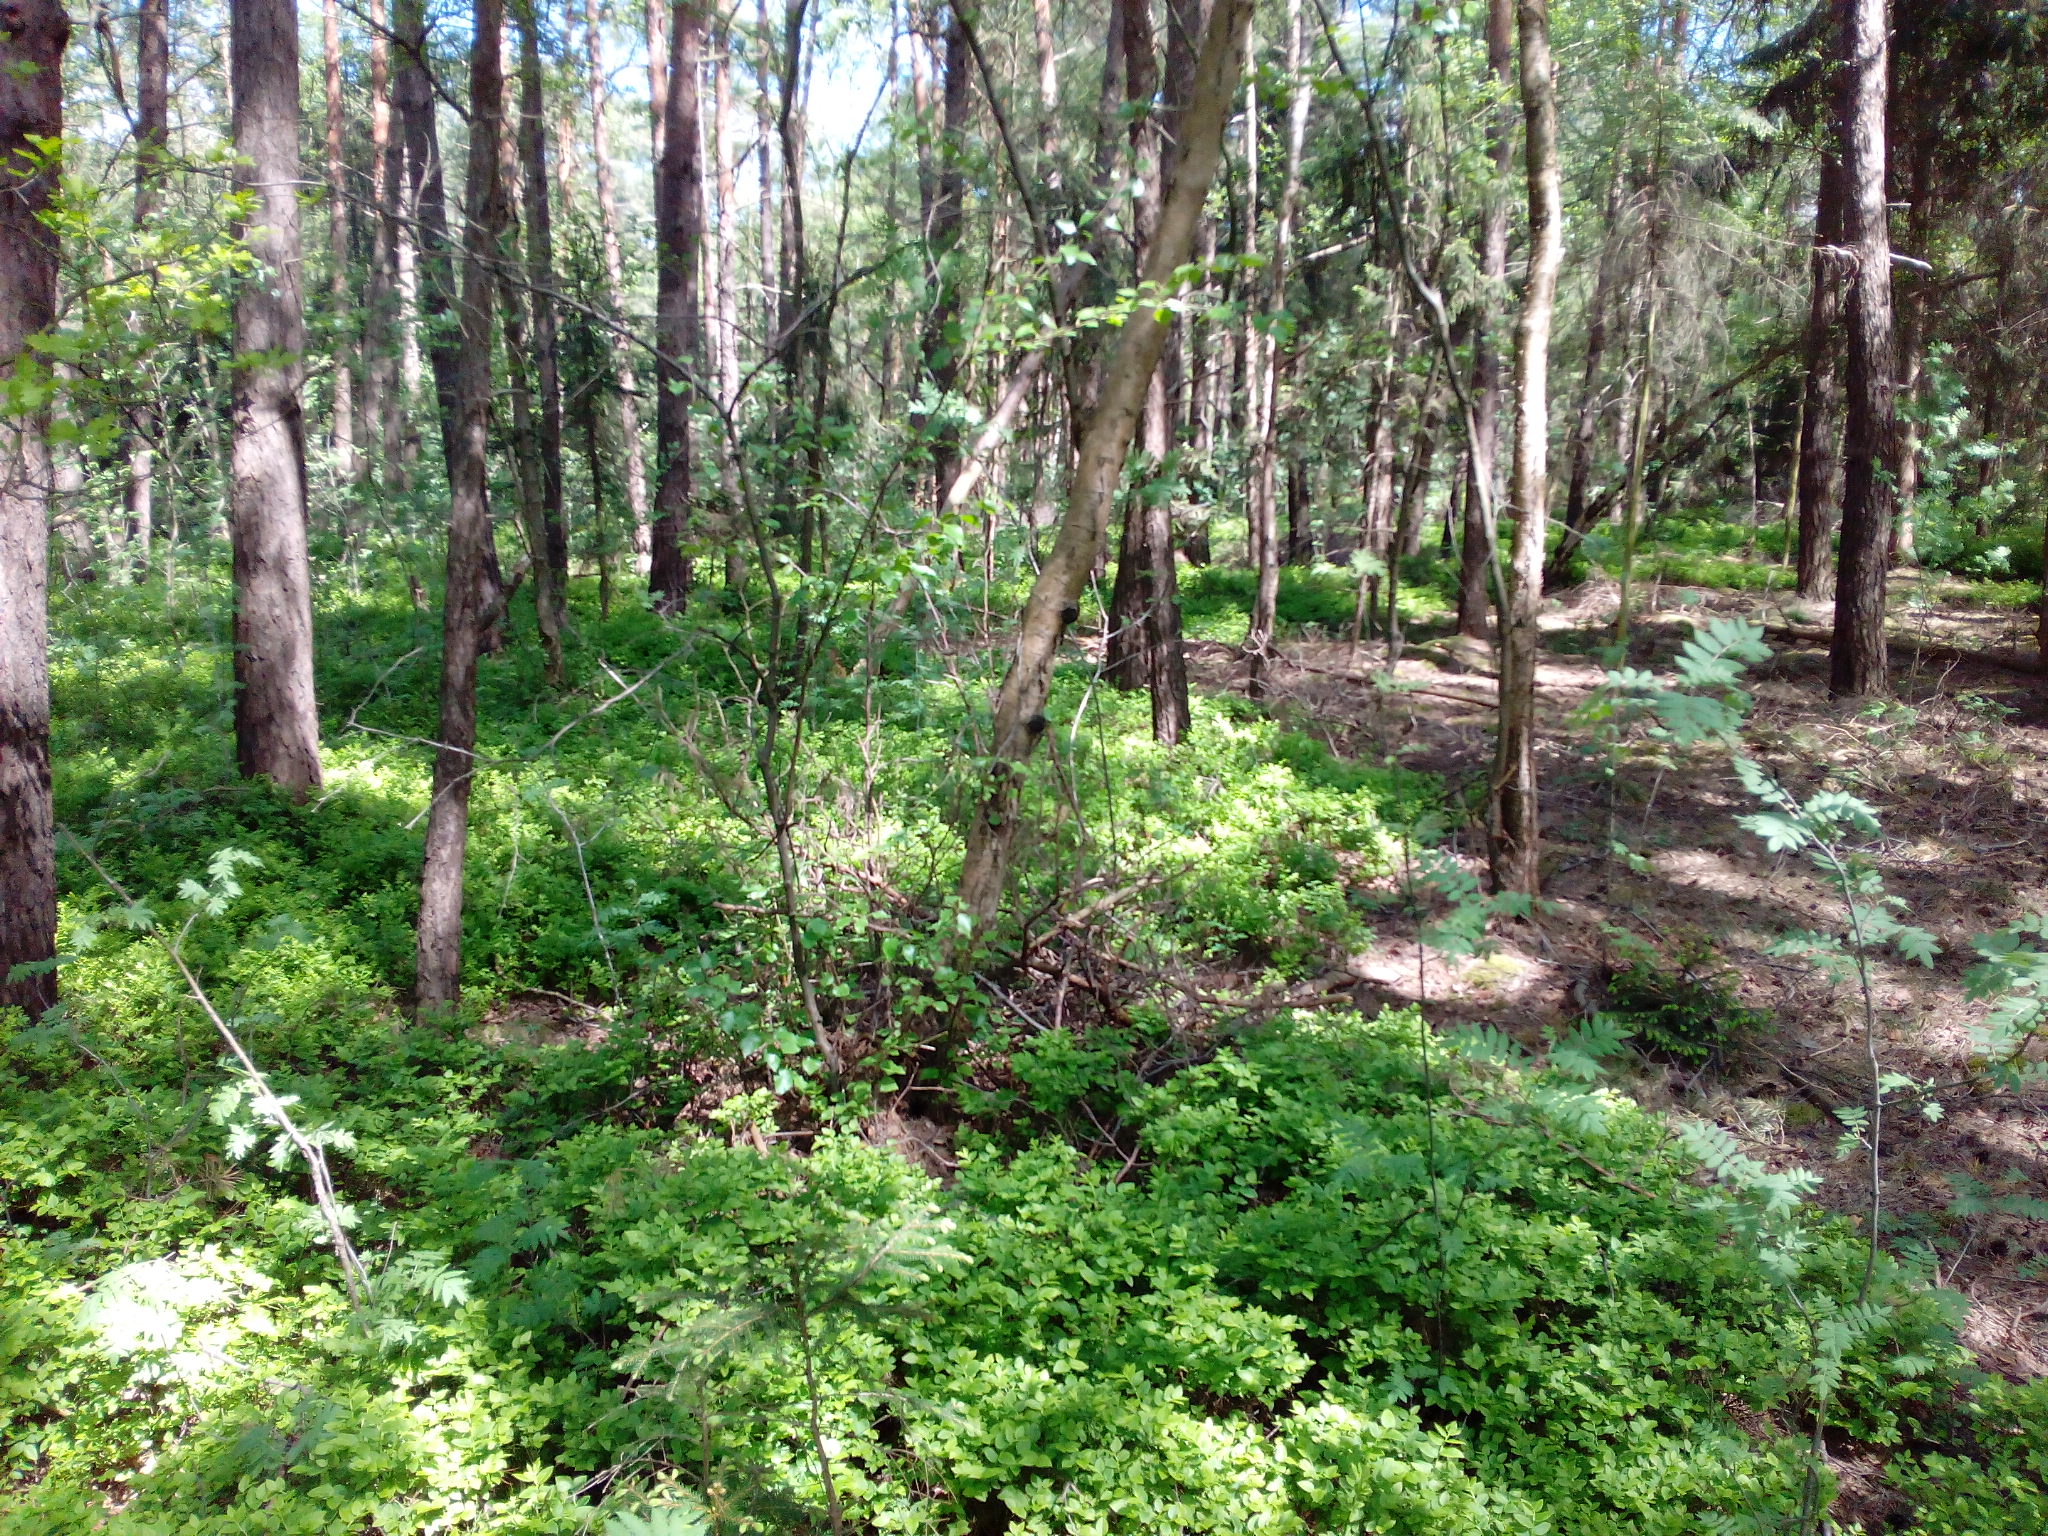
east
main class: Woodland
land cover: Pine dominated mixed woodland
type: hemiboreal forest and nemoral coniferous forest and mixed broadleaved-coniferous forest
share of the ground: > 75 %
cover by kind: coniferous forest trees 60 %, broadleaved forest trees 25 %, herbaceous plants 10 %, unconsolidated bare surface 5 %
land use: Forestry
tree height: > 5 m
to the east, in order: Pine dominated mixed woodland; Tracks; Pine dominated mixed woodland
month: May
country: DE
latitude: 52.4313
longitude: 9.8971
